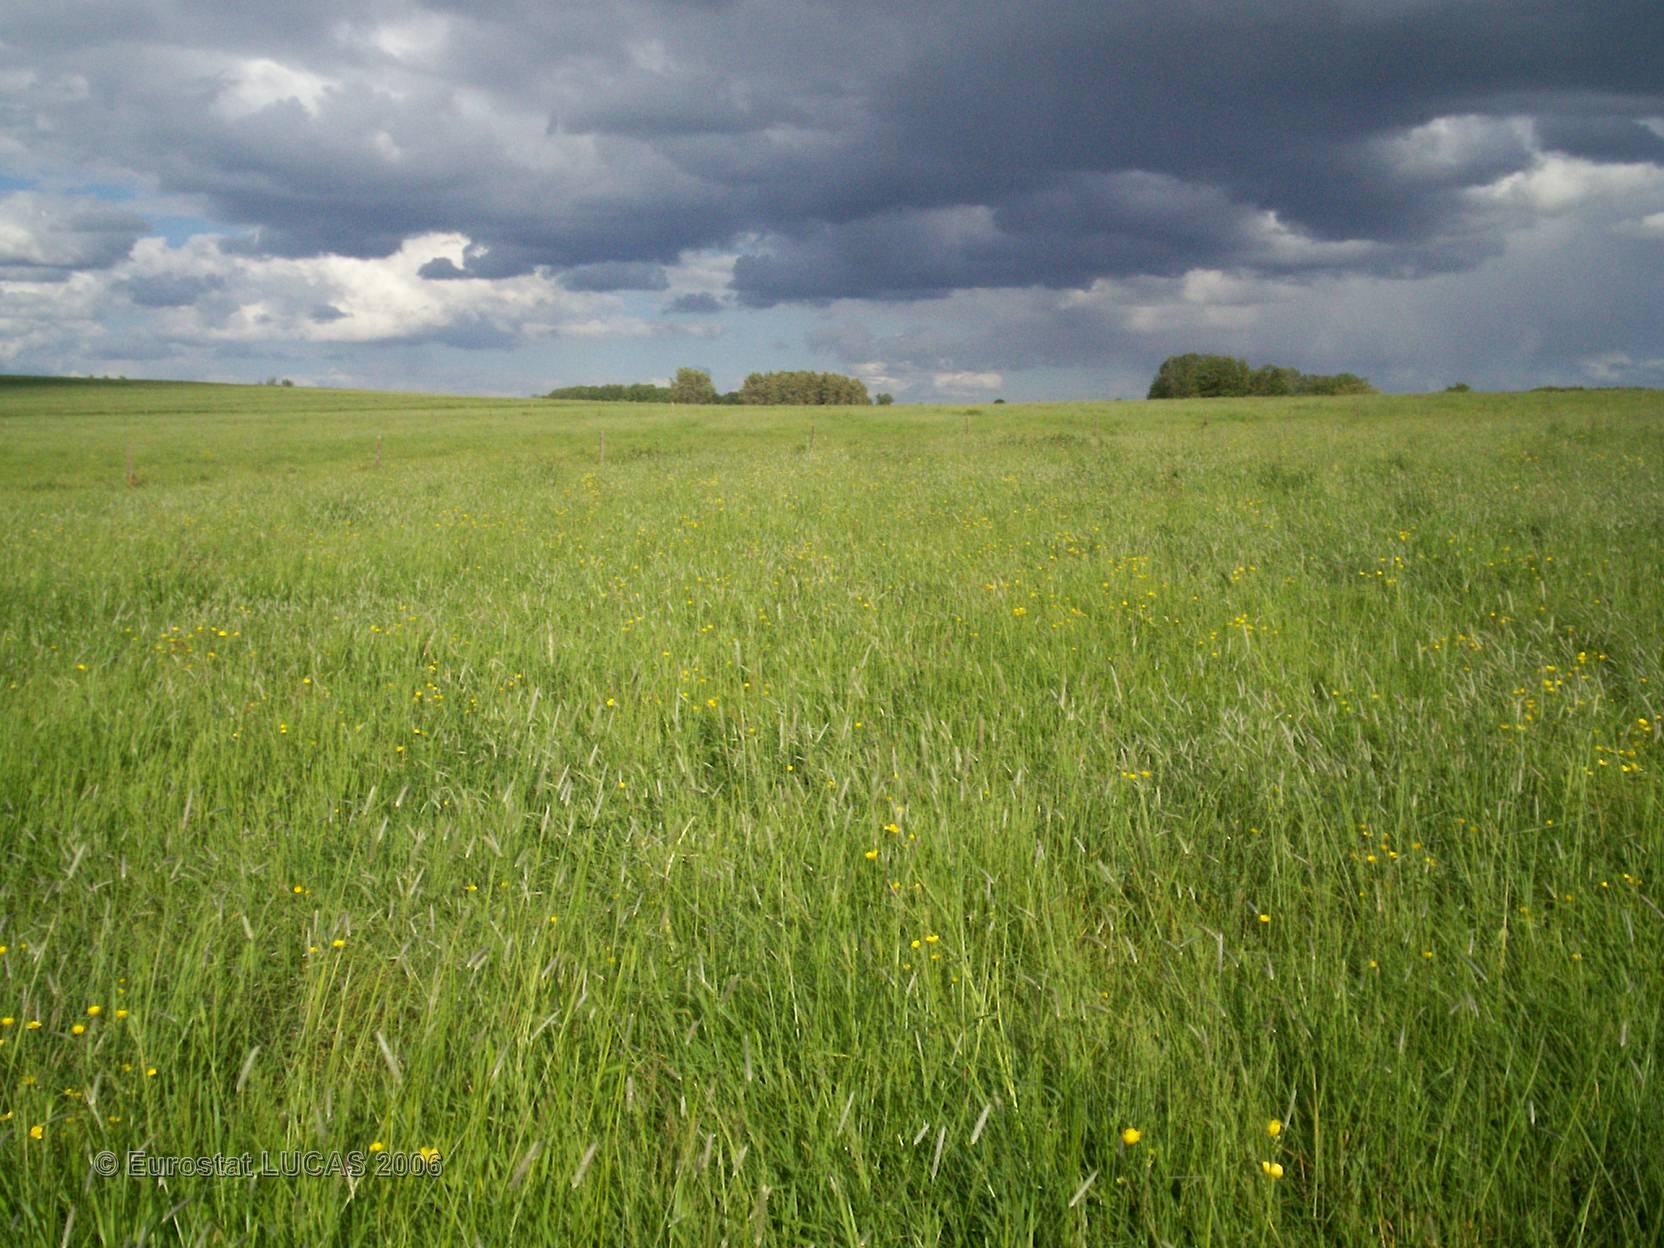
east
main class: Grassland
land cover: Grassland without tree/shrub cover
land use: Agriculture (excluding fallow land and kitchen gardens)
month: May
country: FR
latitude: 48.5183
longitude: 6.7649
